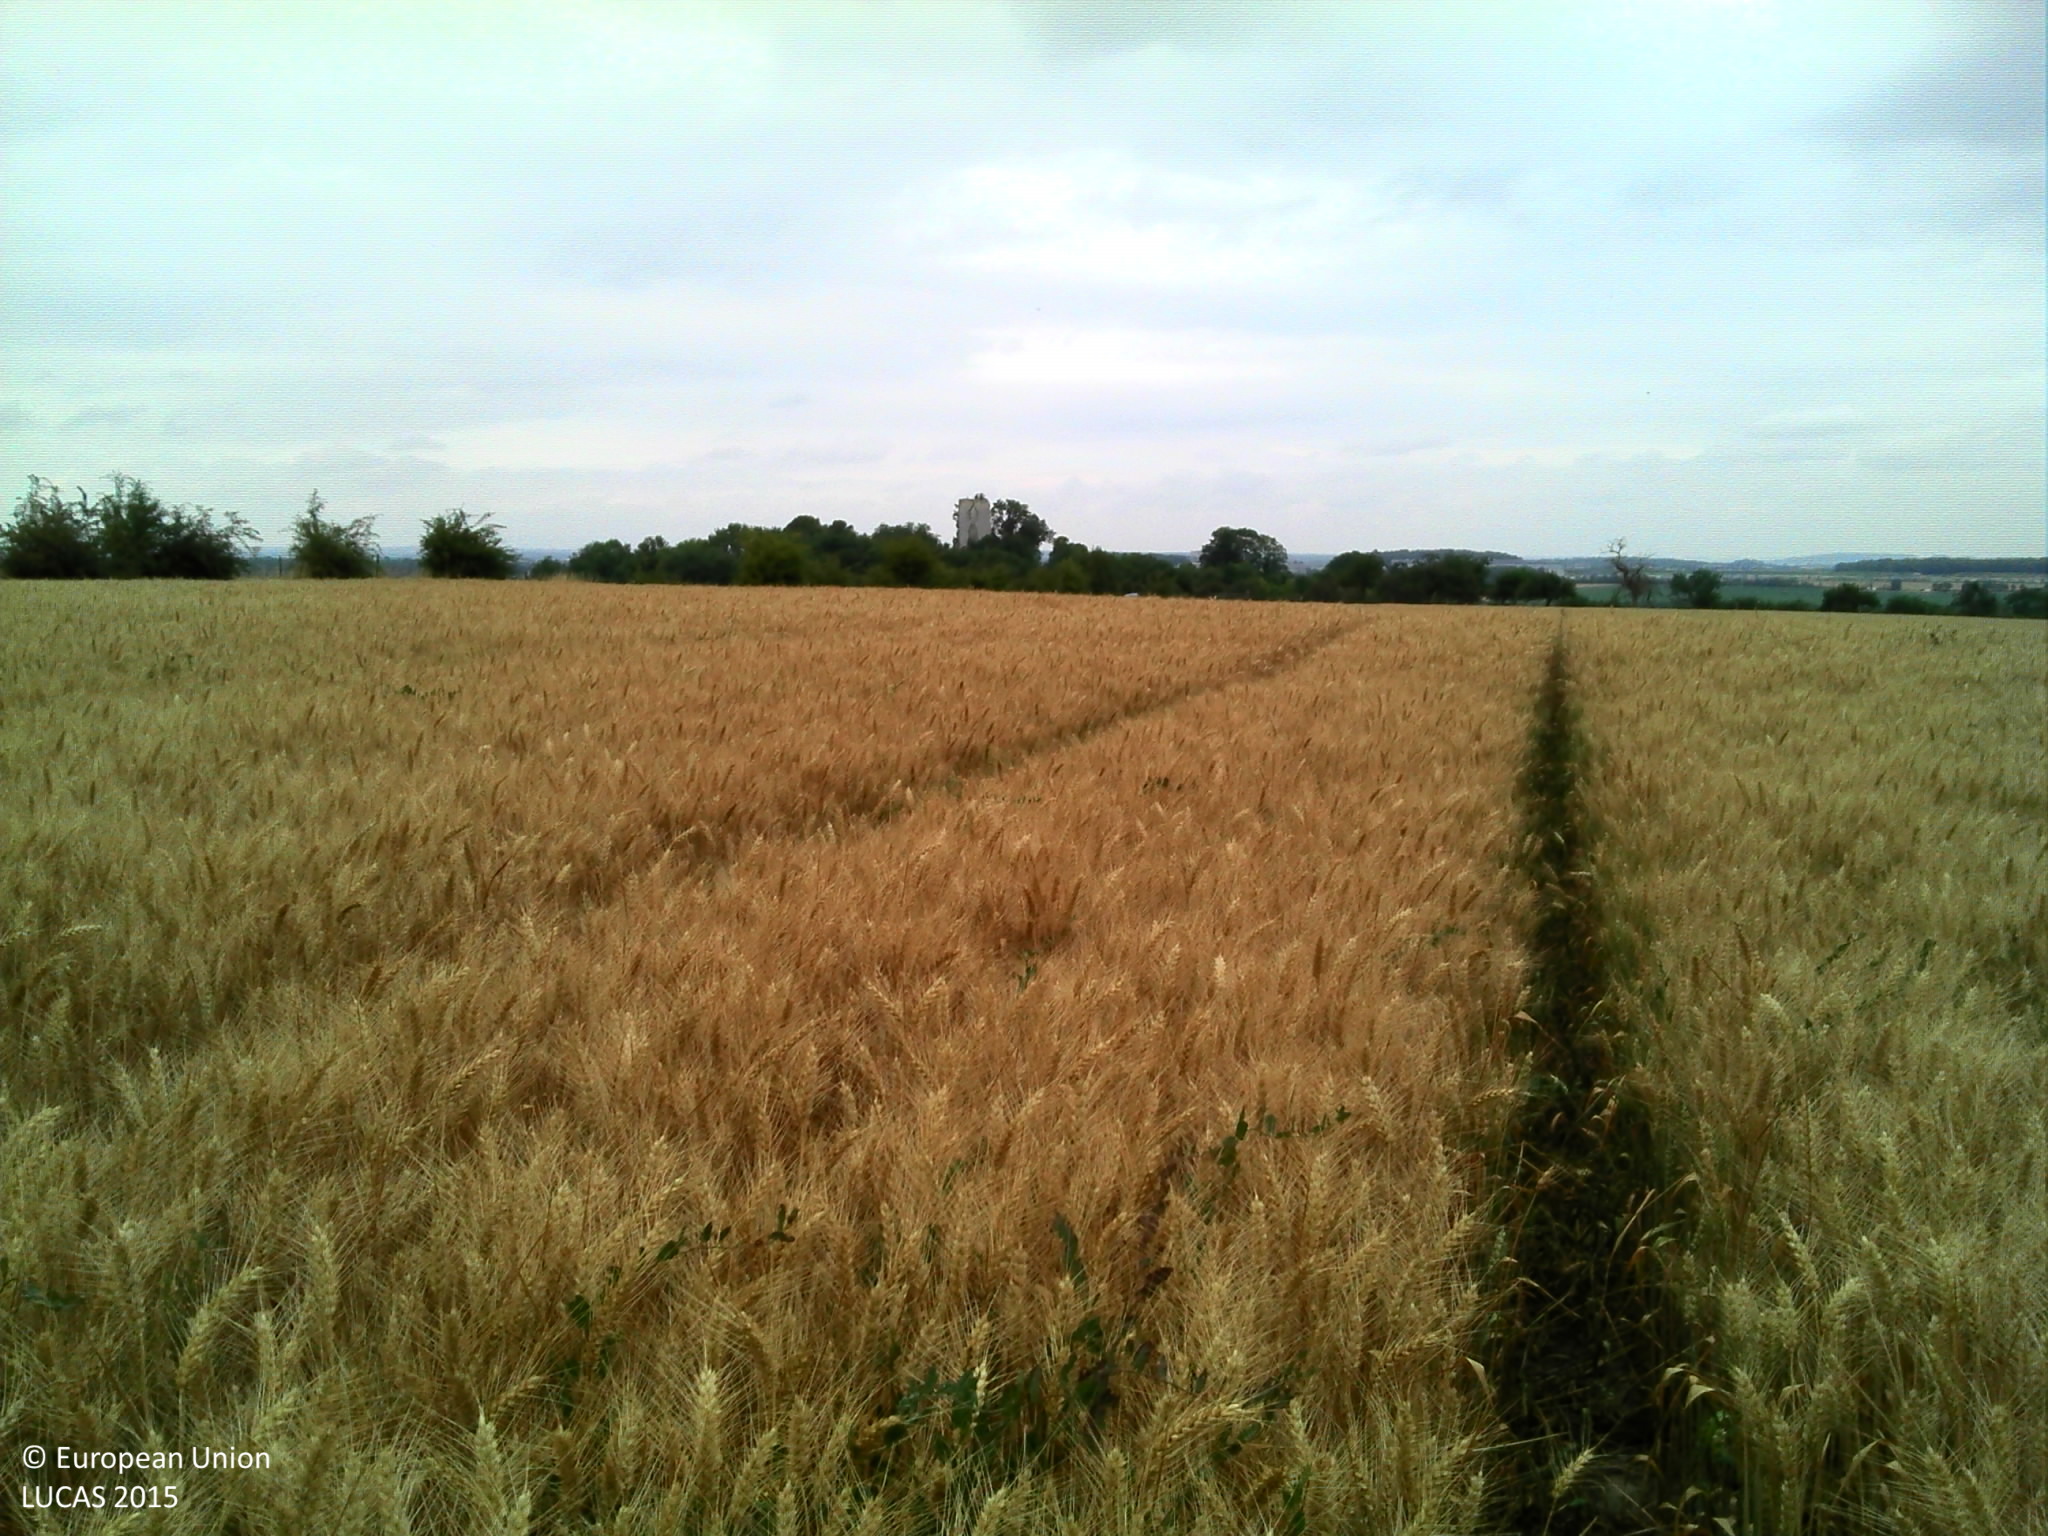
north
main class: Cropland
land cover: Common wheat
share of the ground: > 75 %
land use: Agriculture (excluding fallow land and kitchen gardens)
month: July
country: FR
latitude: 49.8388
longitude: 2.3812
